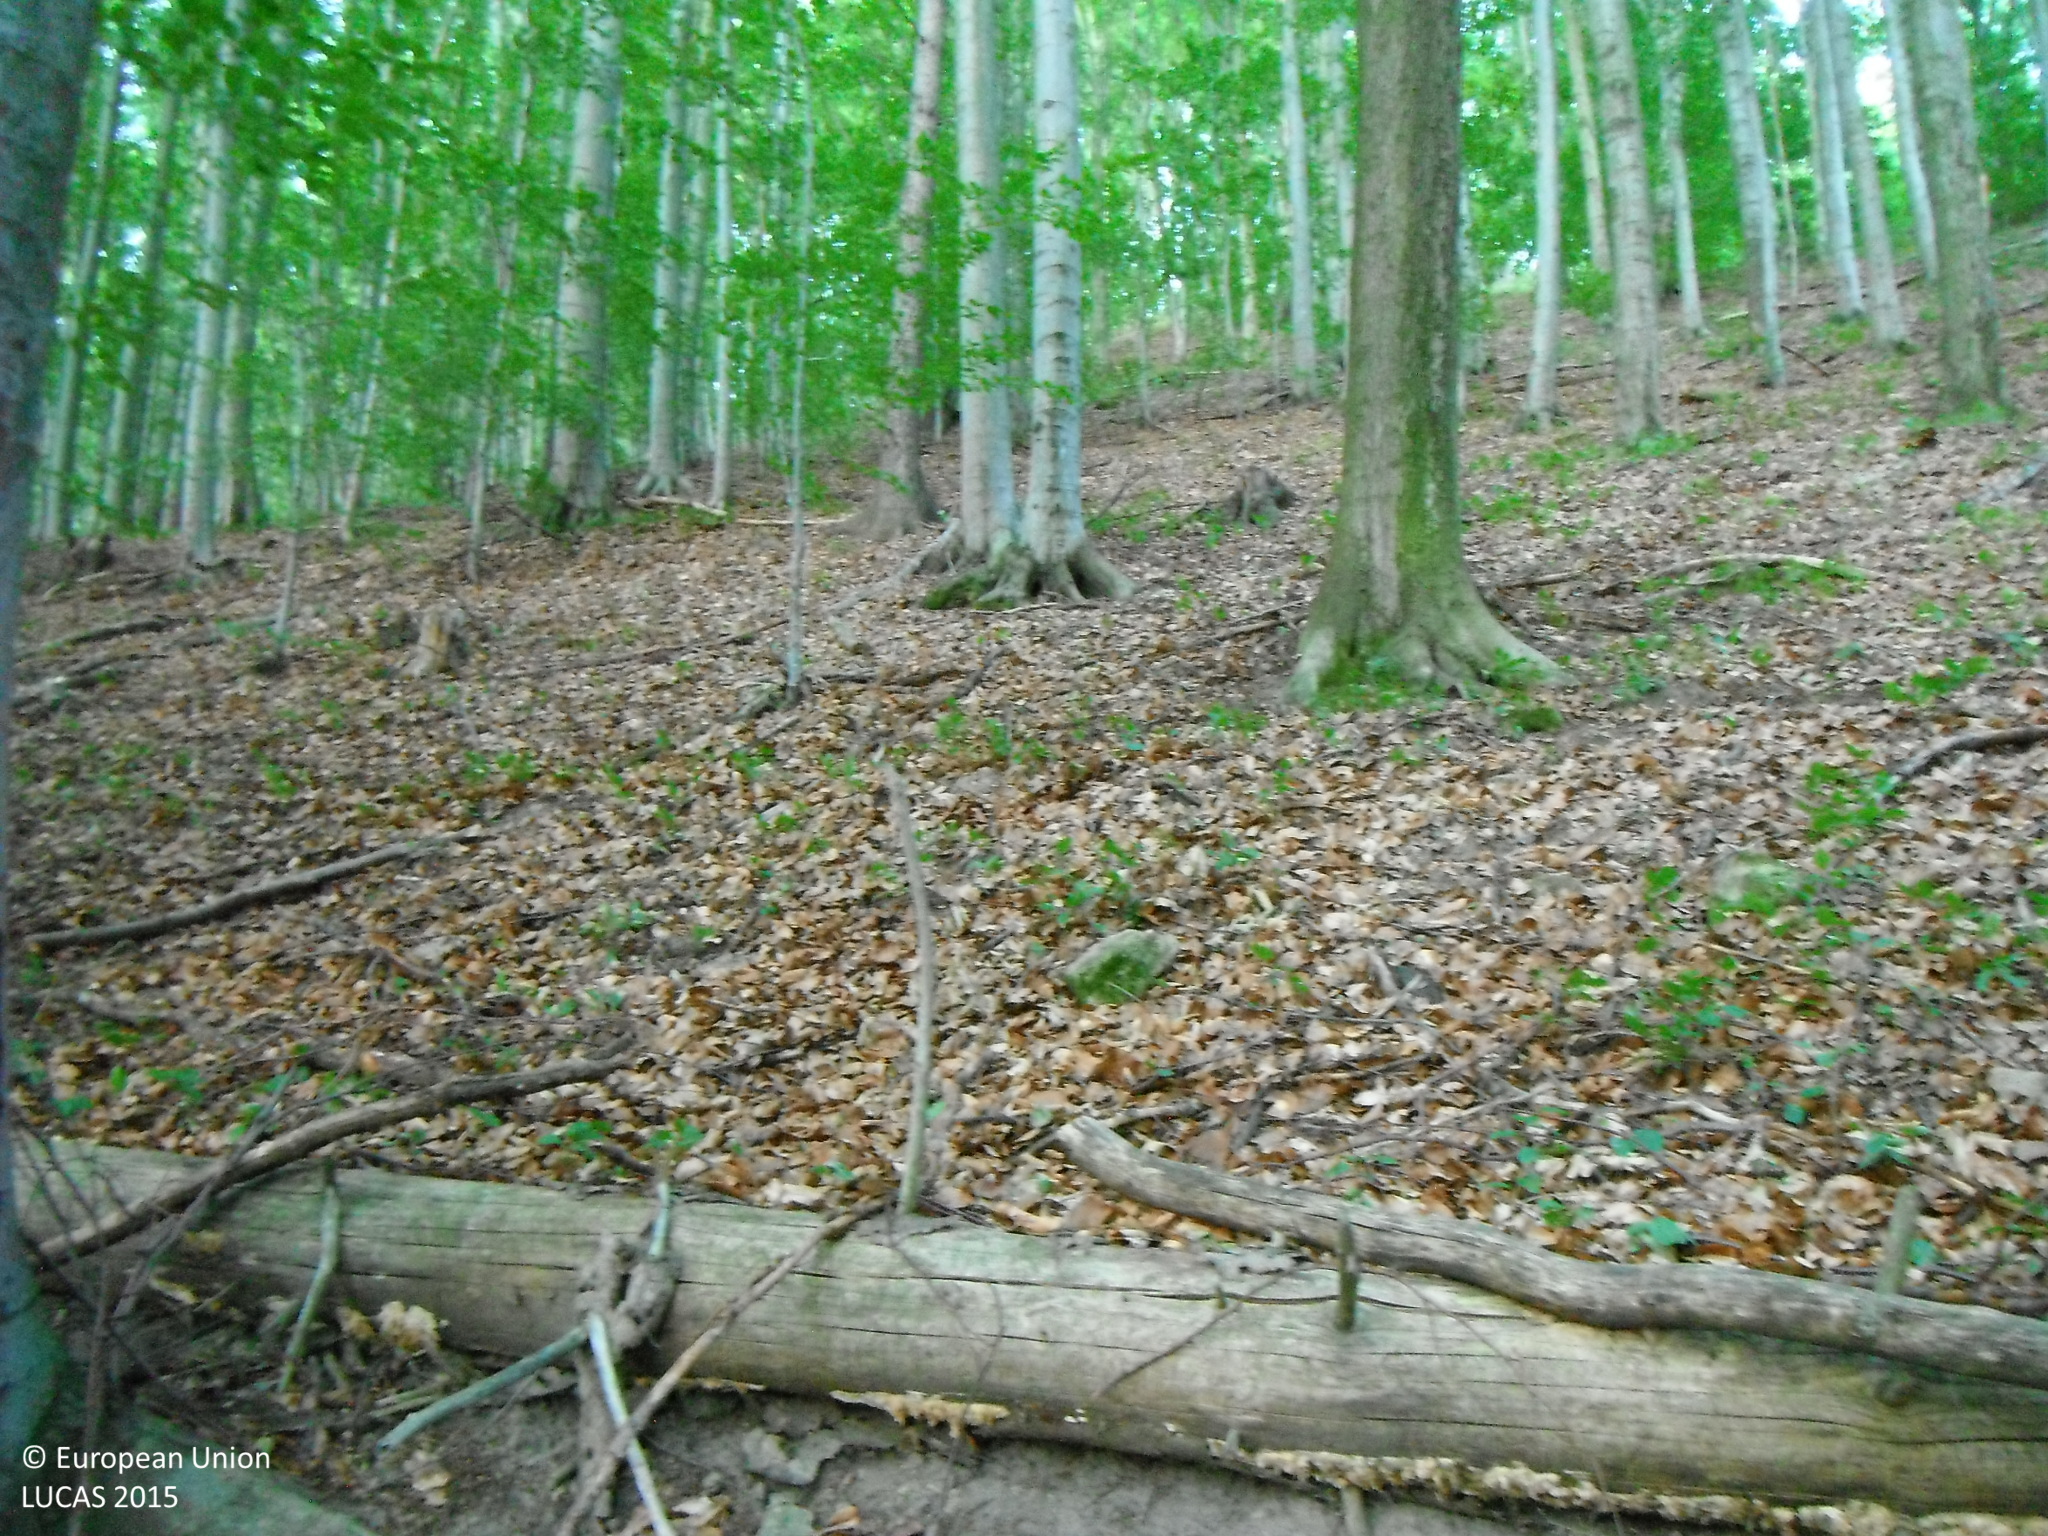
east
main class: Woodland
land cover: Broadleaved woodland
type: beech forest
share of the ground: > 75 %
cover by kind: broadleaved forest trees 100 %
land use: Forestry
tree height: > 5 m
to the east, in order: Broadleaved woodland; Grassland without tree/shrub cover; Broadleaved woodland; Grassland without tree/shrub cover
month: July
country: SK
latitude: 48.5470
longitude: 18.9473
